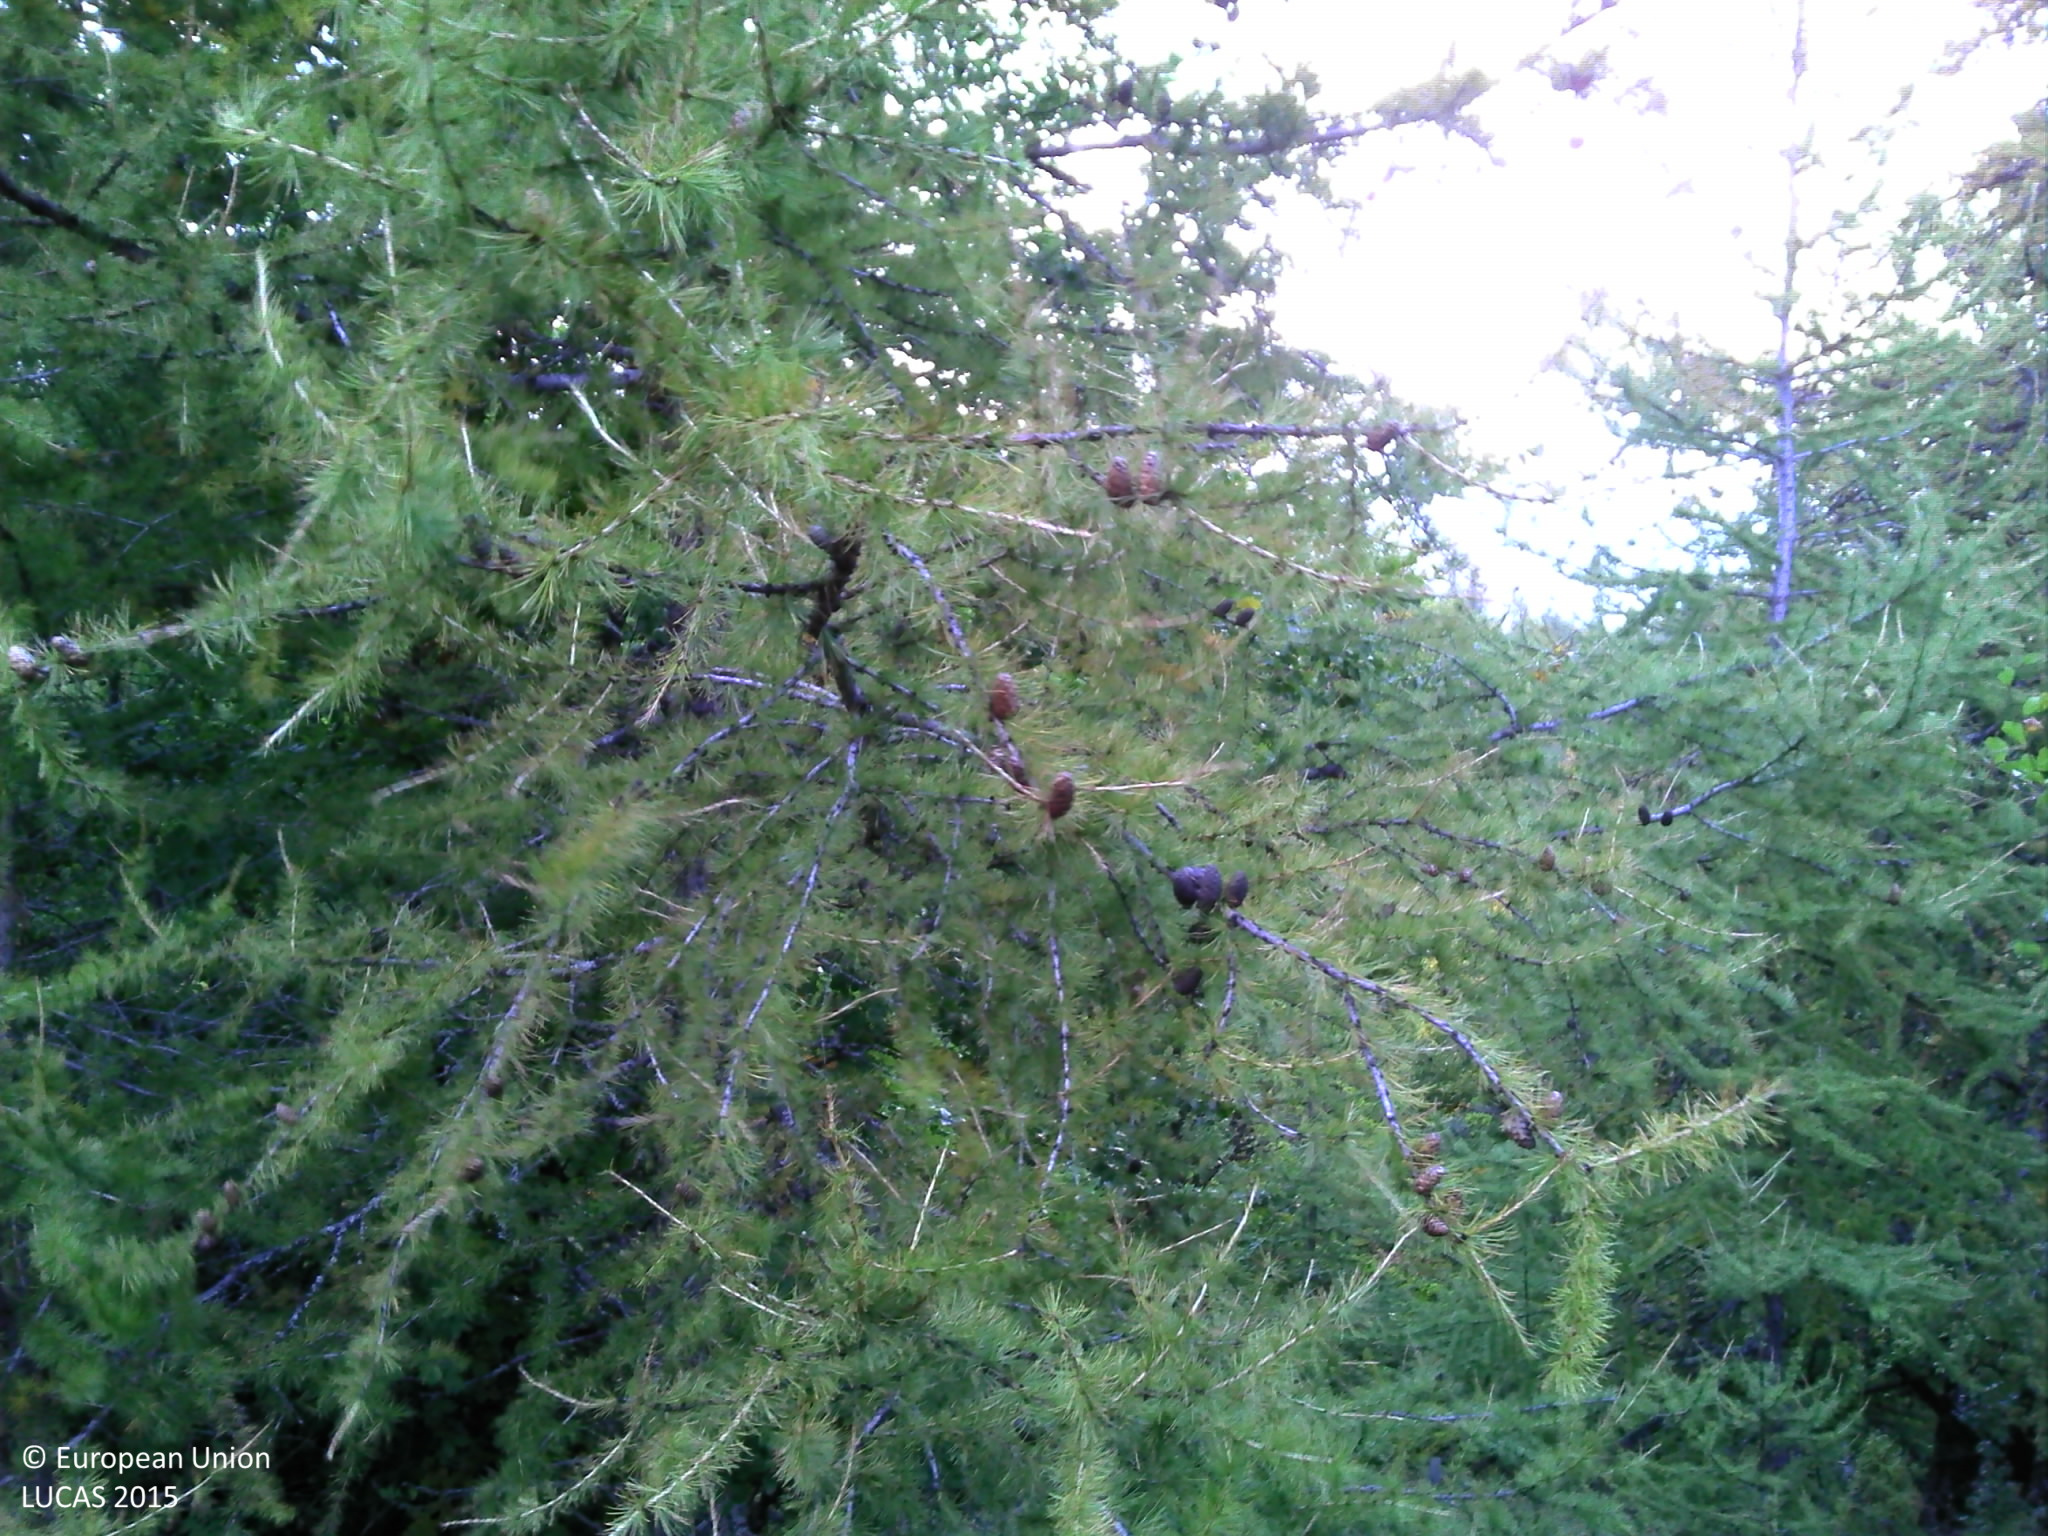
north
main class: Grassland
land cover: Grassland with sparse tree/shrub cover
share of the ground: > 75 %
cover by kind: herbaceous plants 85 %, shrubs 10 %, coniferous forest trees 5 %
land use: Agriculture (excluding fallow land and kitchen gardens)
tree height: > 5 m
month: September
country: FR
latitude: 44.4984
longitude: 6.2211
